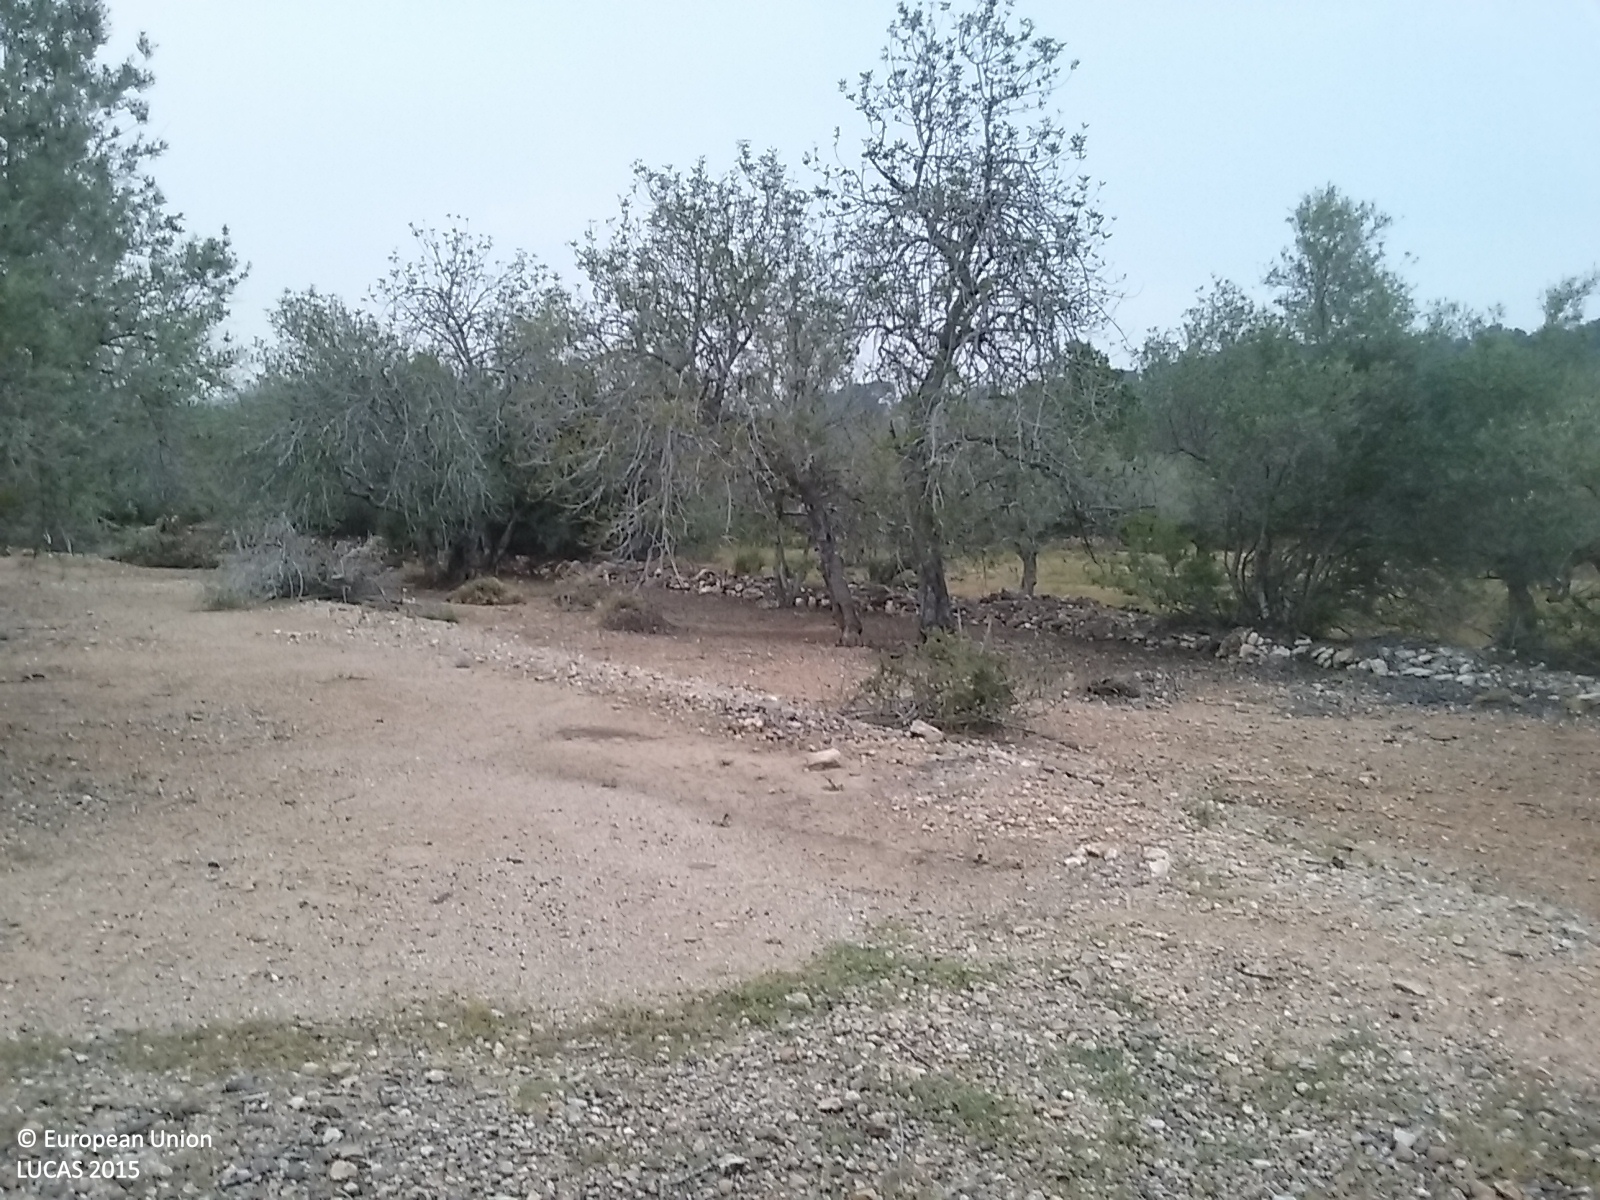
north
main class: Cropland
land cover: Olive groves
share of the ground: 25 - 50 %
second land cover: Other bare soil
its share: > 75 %
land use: Agriculture (excluding fallow land and kitchen gardens)
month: April
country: ES
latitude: 40.8444
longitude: 0.7074
